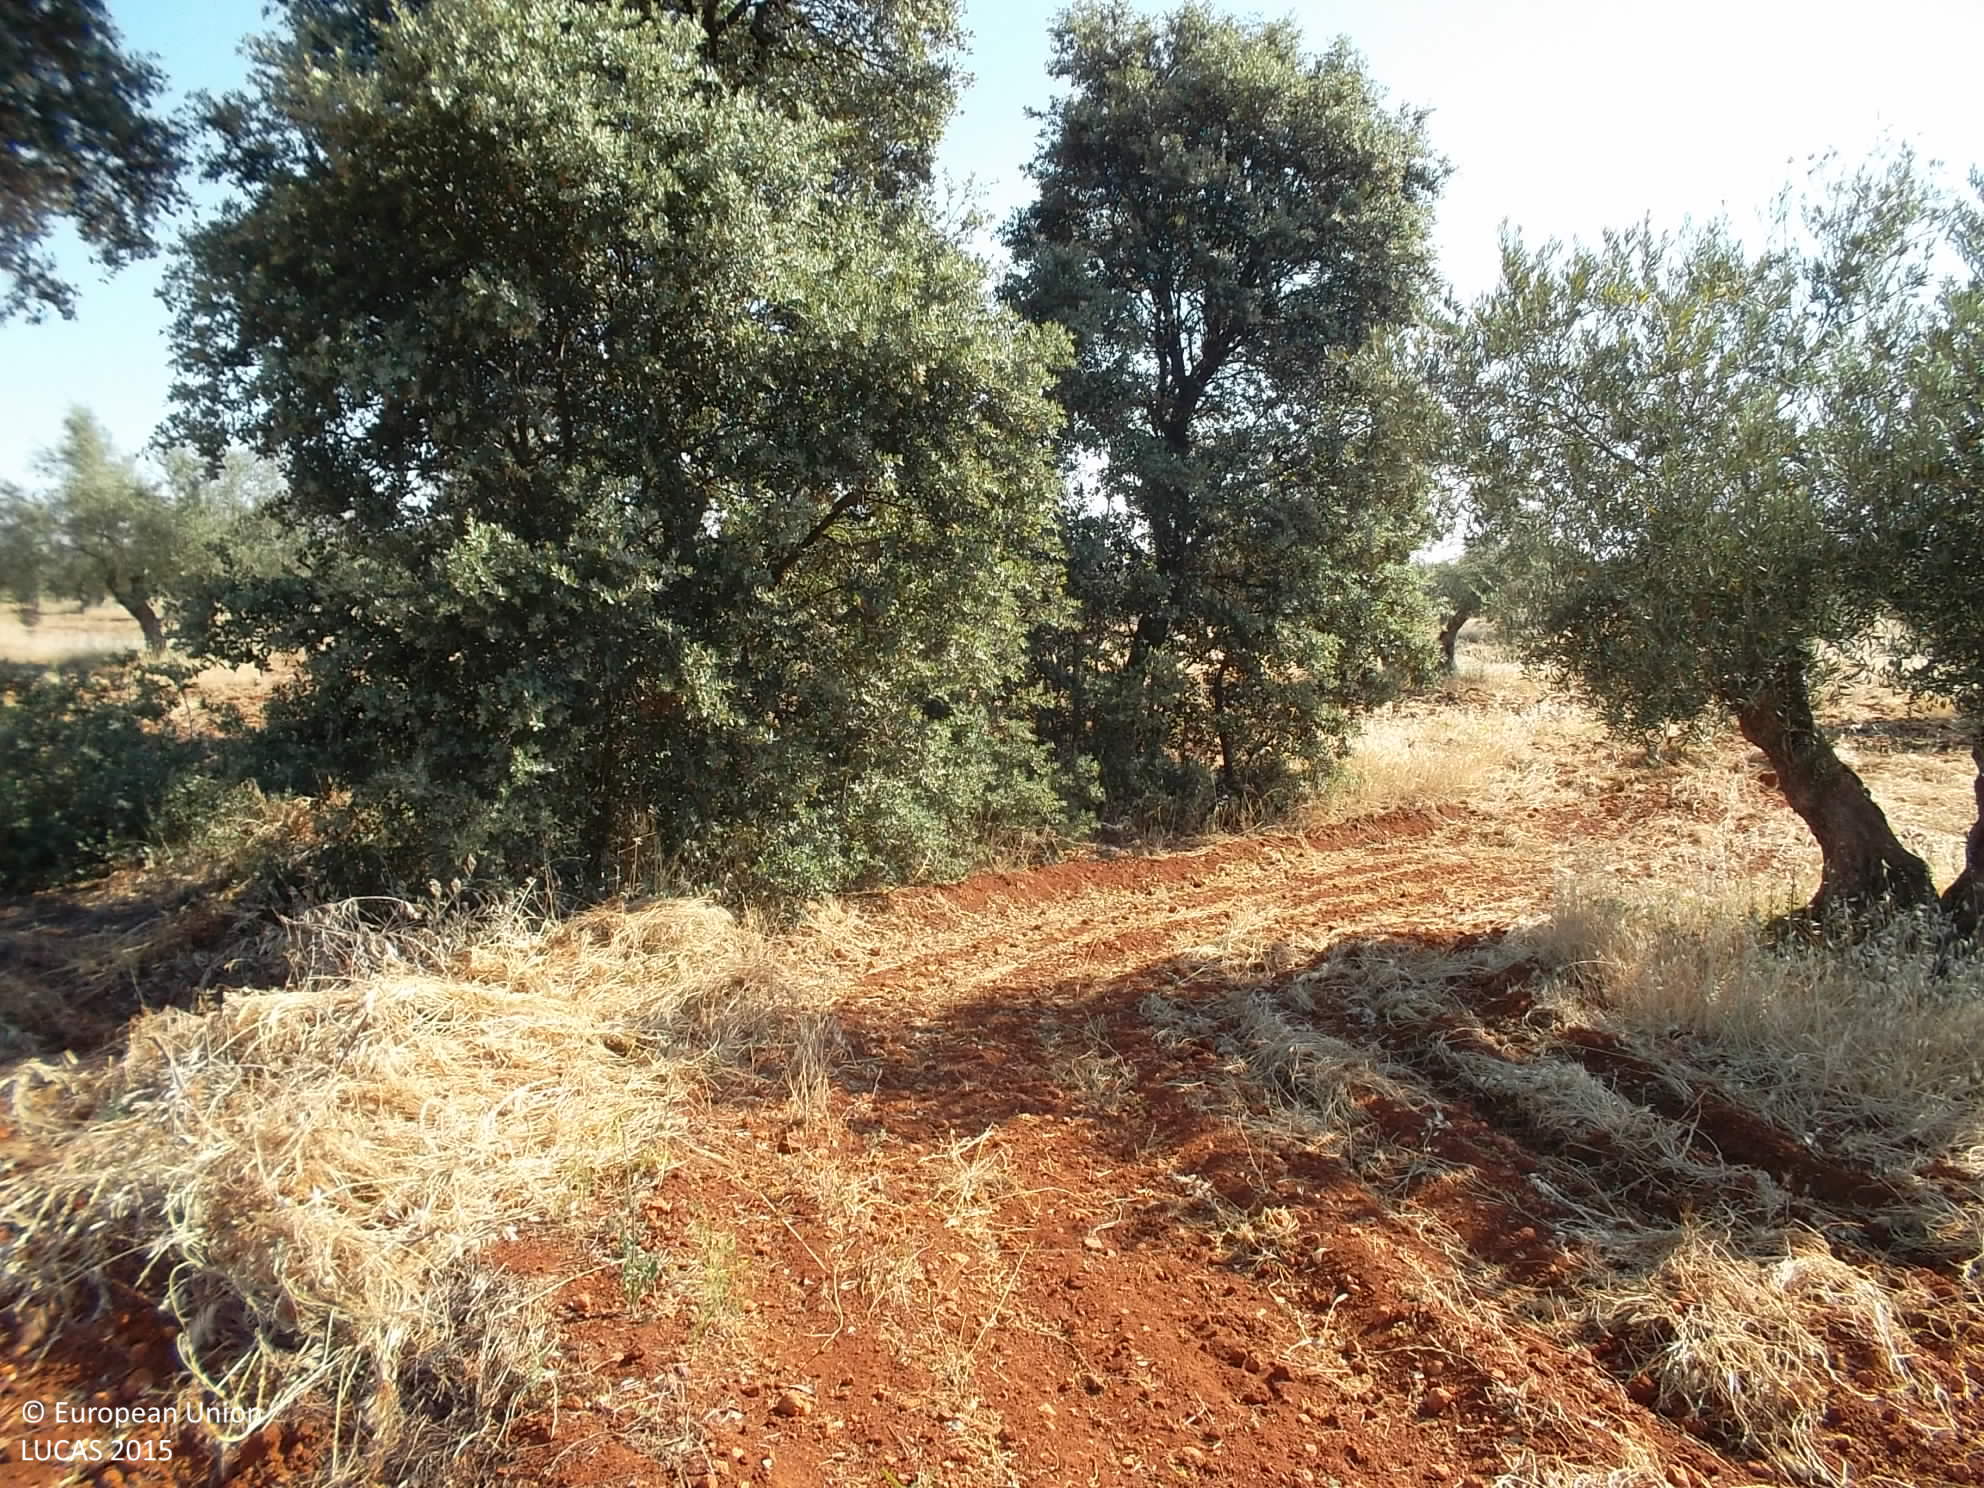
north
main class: Cropland
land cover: Olive groves
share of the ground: 10 - 25 %
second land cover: Other bare soil
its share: > 75 %
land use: Agriculture (excluding fallow land and kitchen gardens)
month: June
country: ES
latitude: 38.7416
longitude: -4.0196
